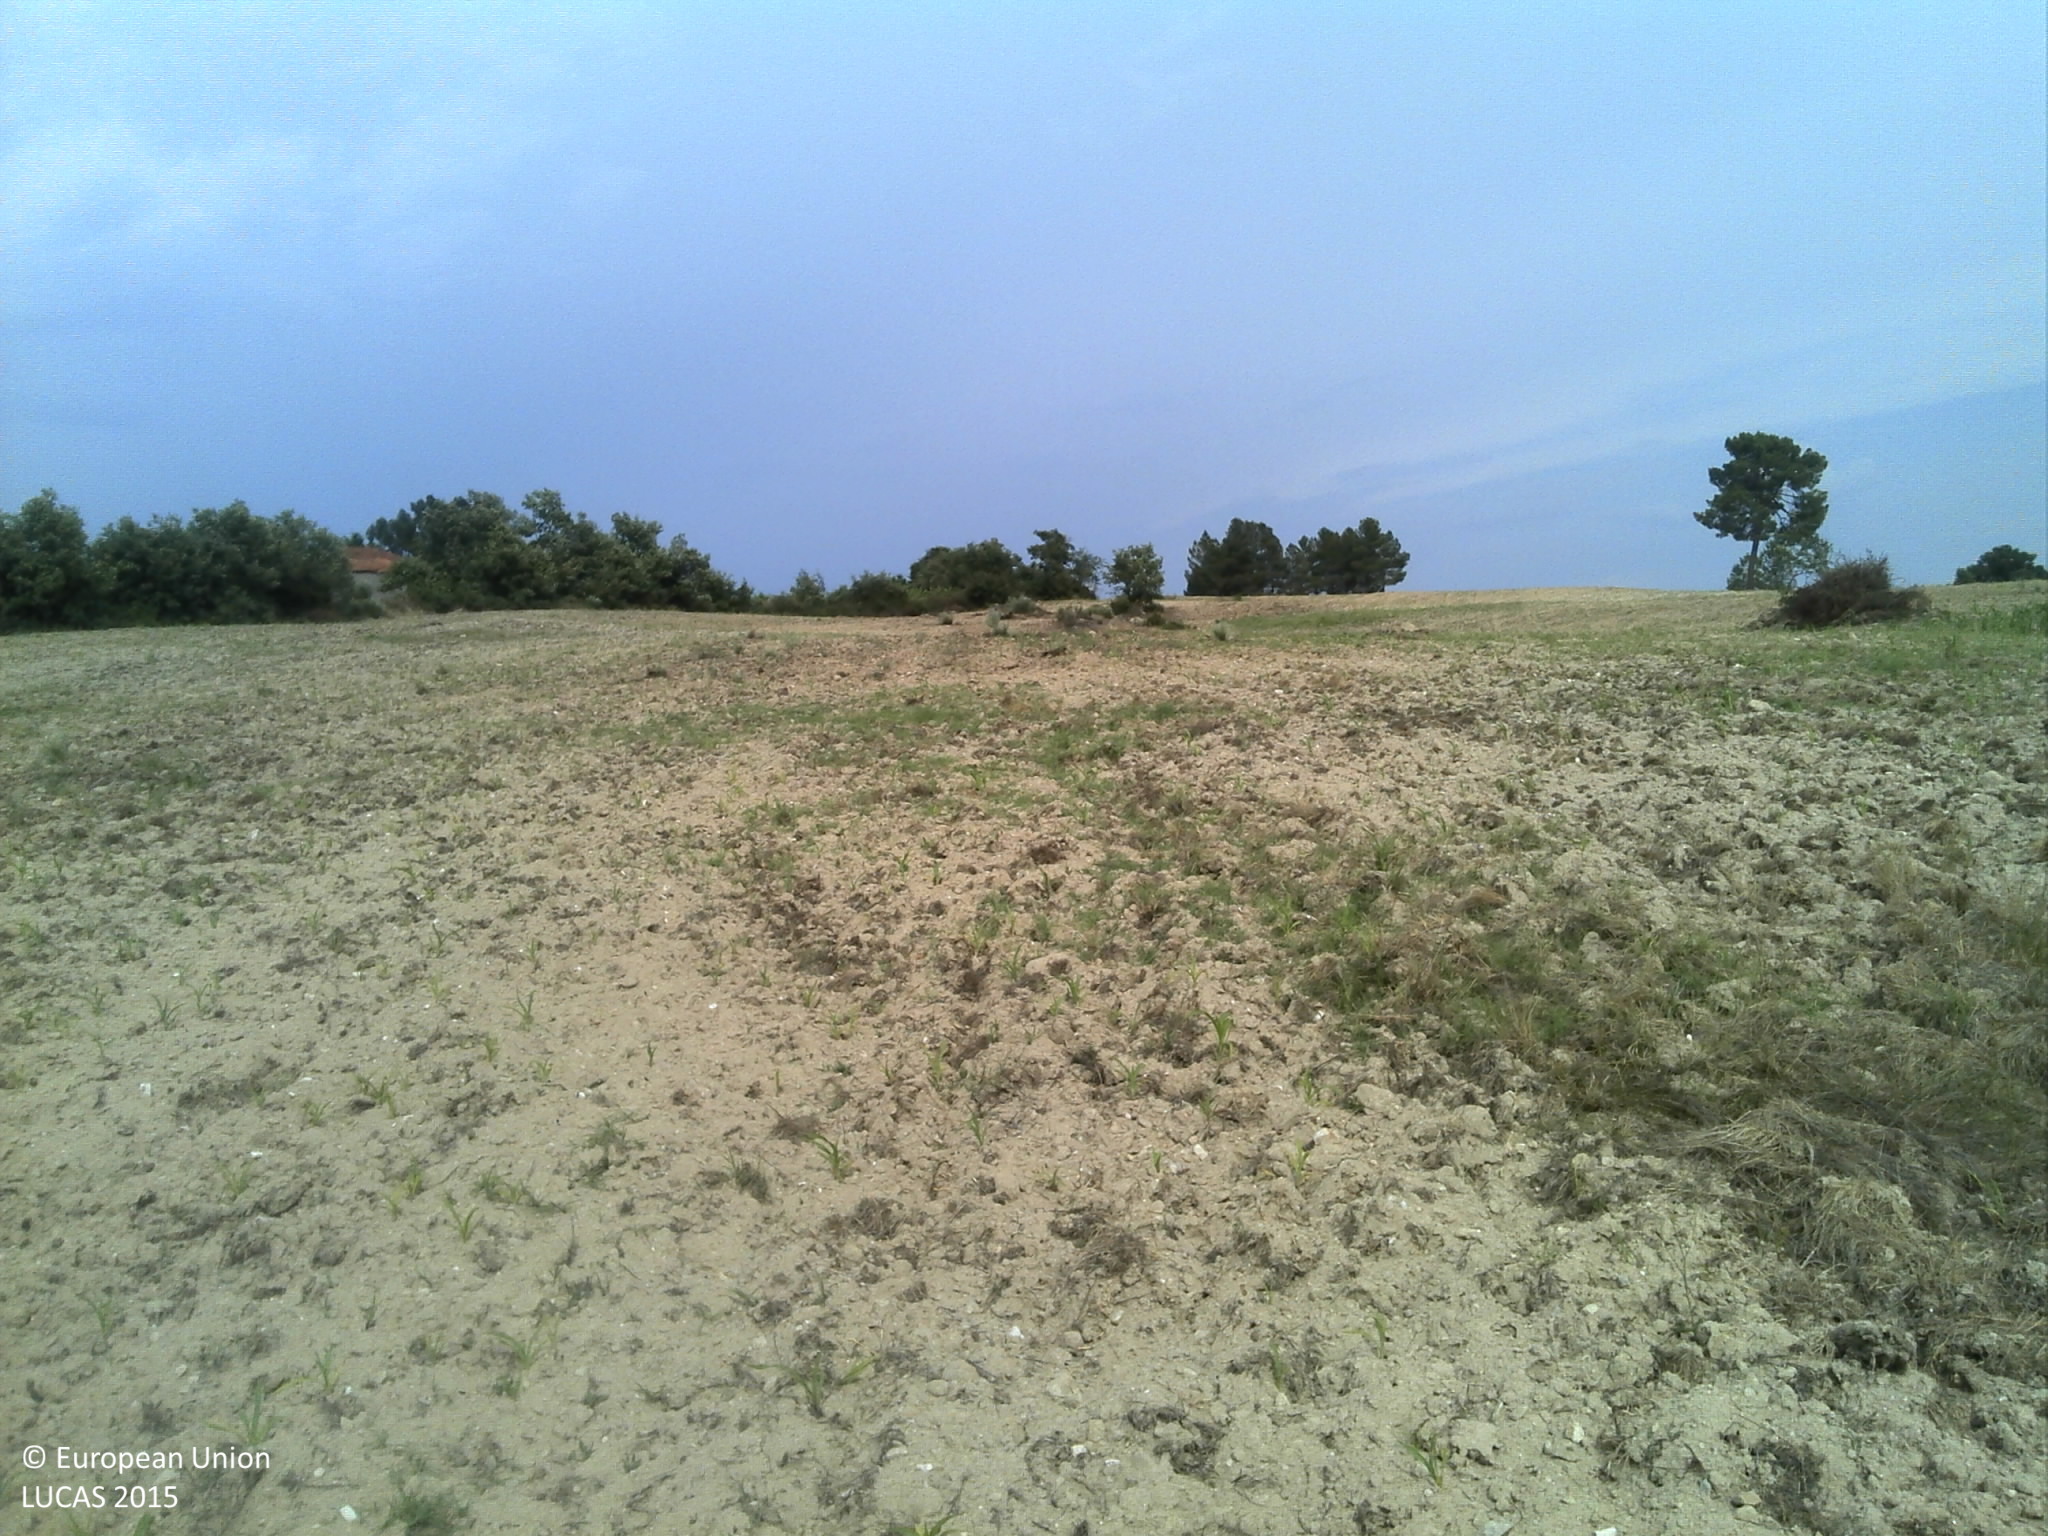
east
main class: Cropland
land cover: Maize
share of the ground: < 10 %
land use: Agriculture (excluding fallow land and kitchen gardens)
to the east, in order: Maize; Abandoned hedges; Fences; Grass margins; Vineyards; Tracks; Electric lines; Vineyards
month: June
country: PT
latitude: 40.2712
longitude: -7.3794
